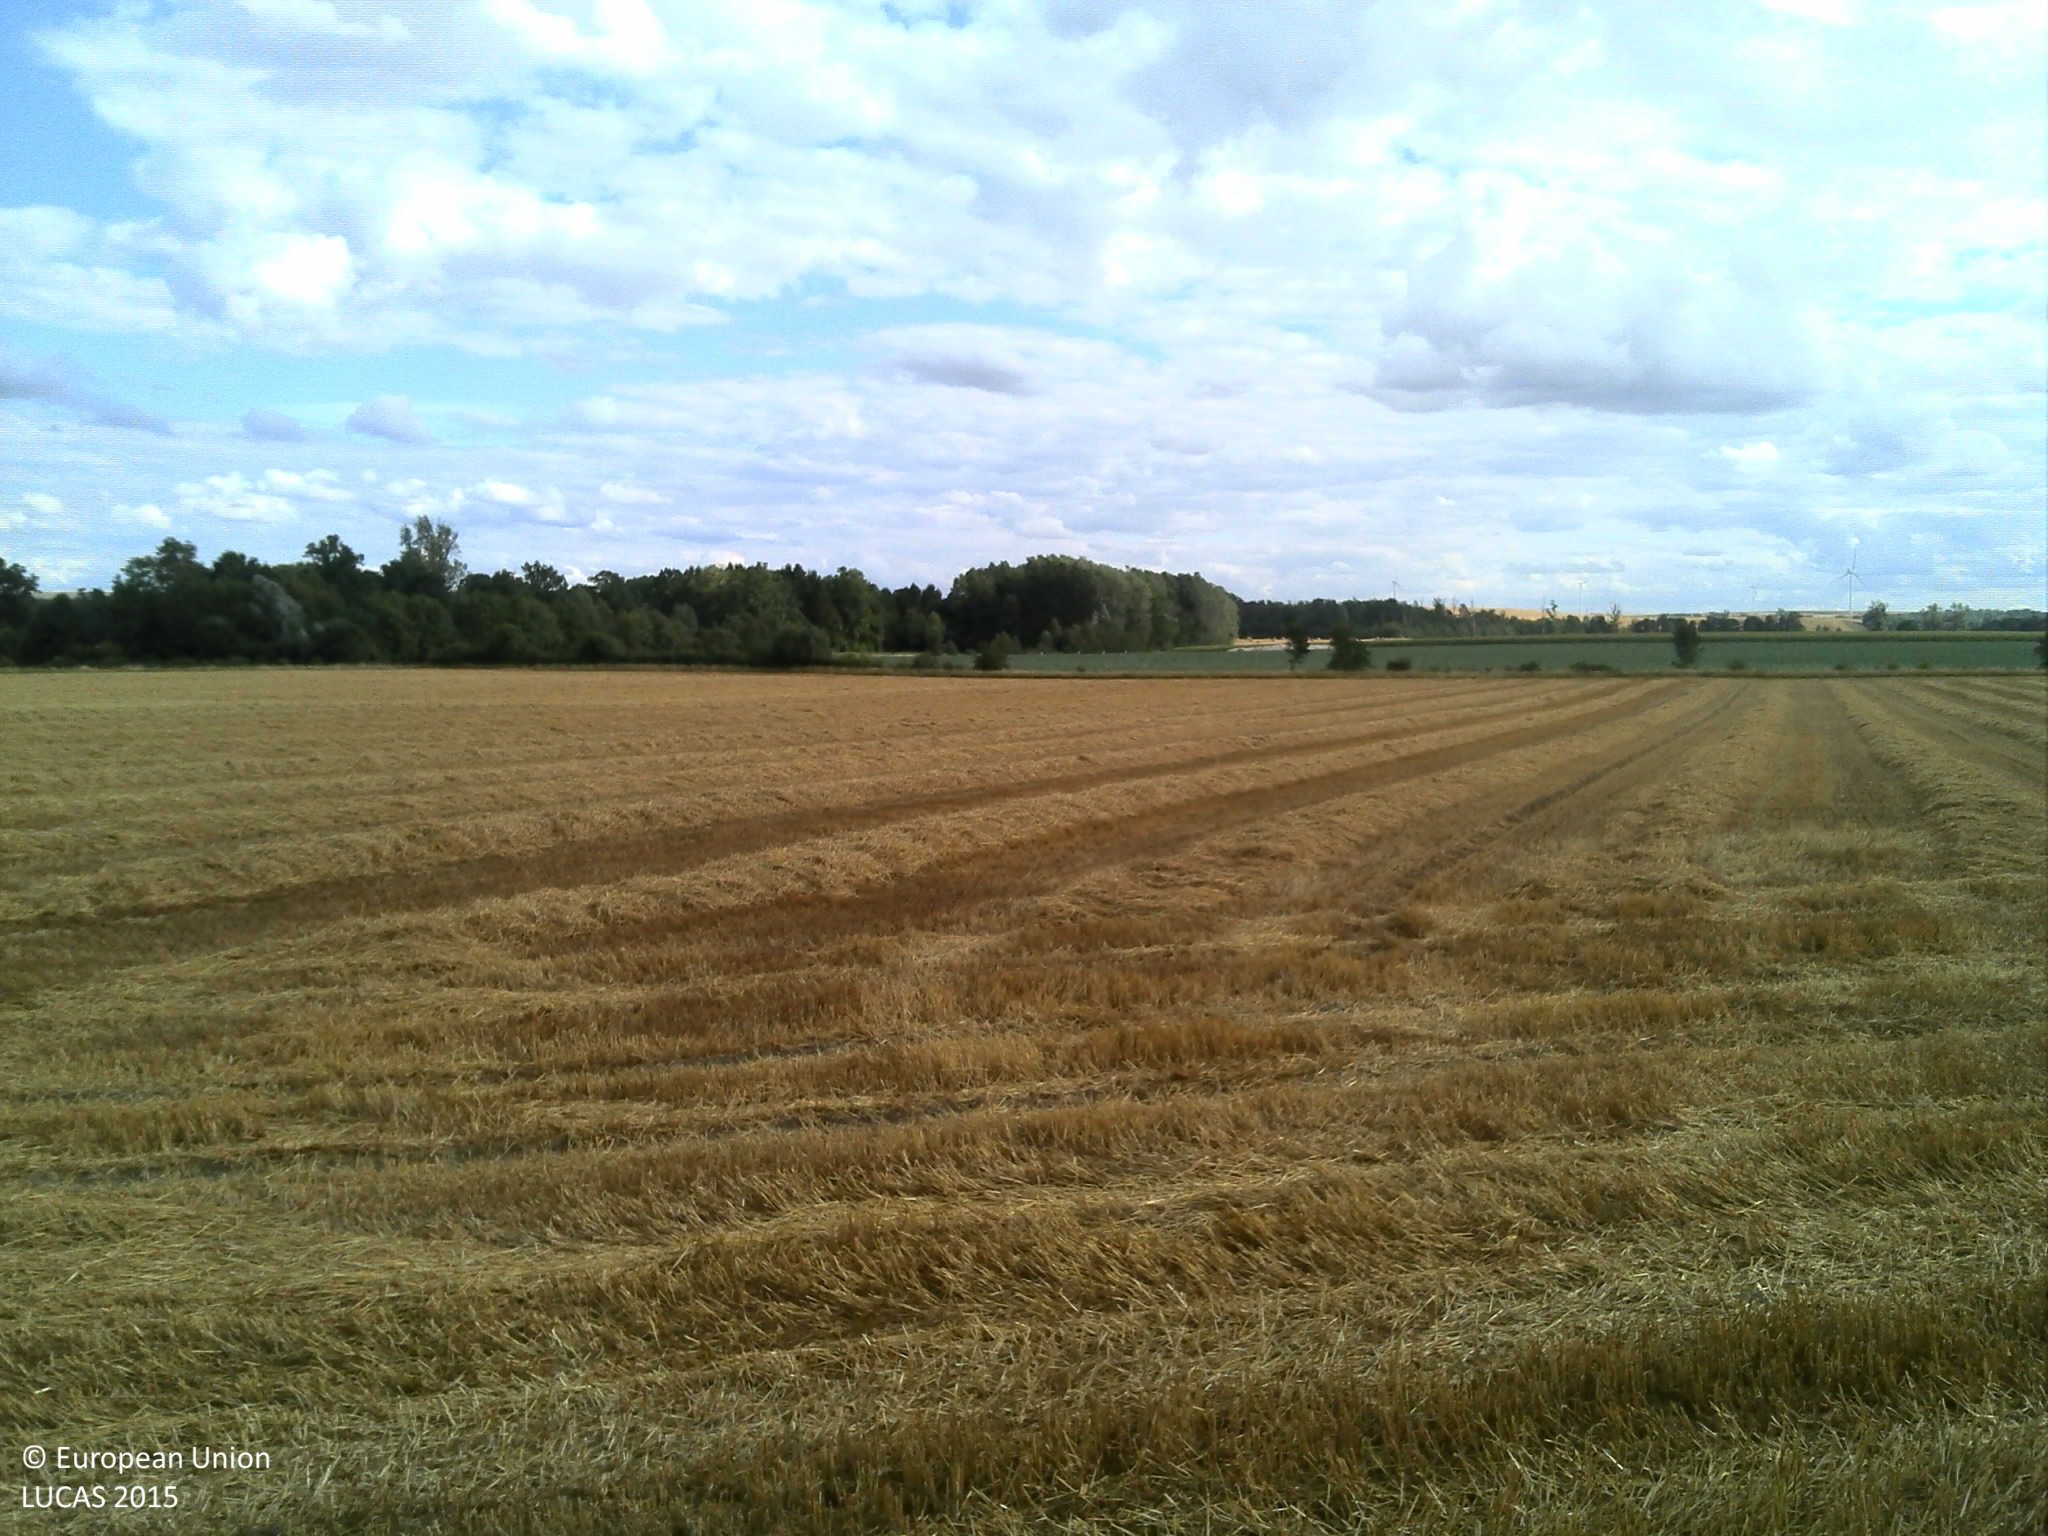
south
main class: Cropland
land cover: Maize
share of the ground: > 75 %
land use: Agriculture (excluding fallow land and kitchen gardens)
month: July
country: FR
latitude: 49.4755
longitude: 4.5173
